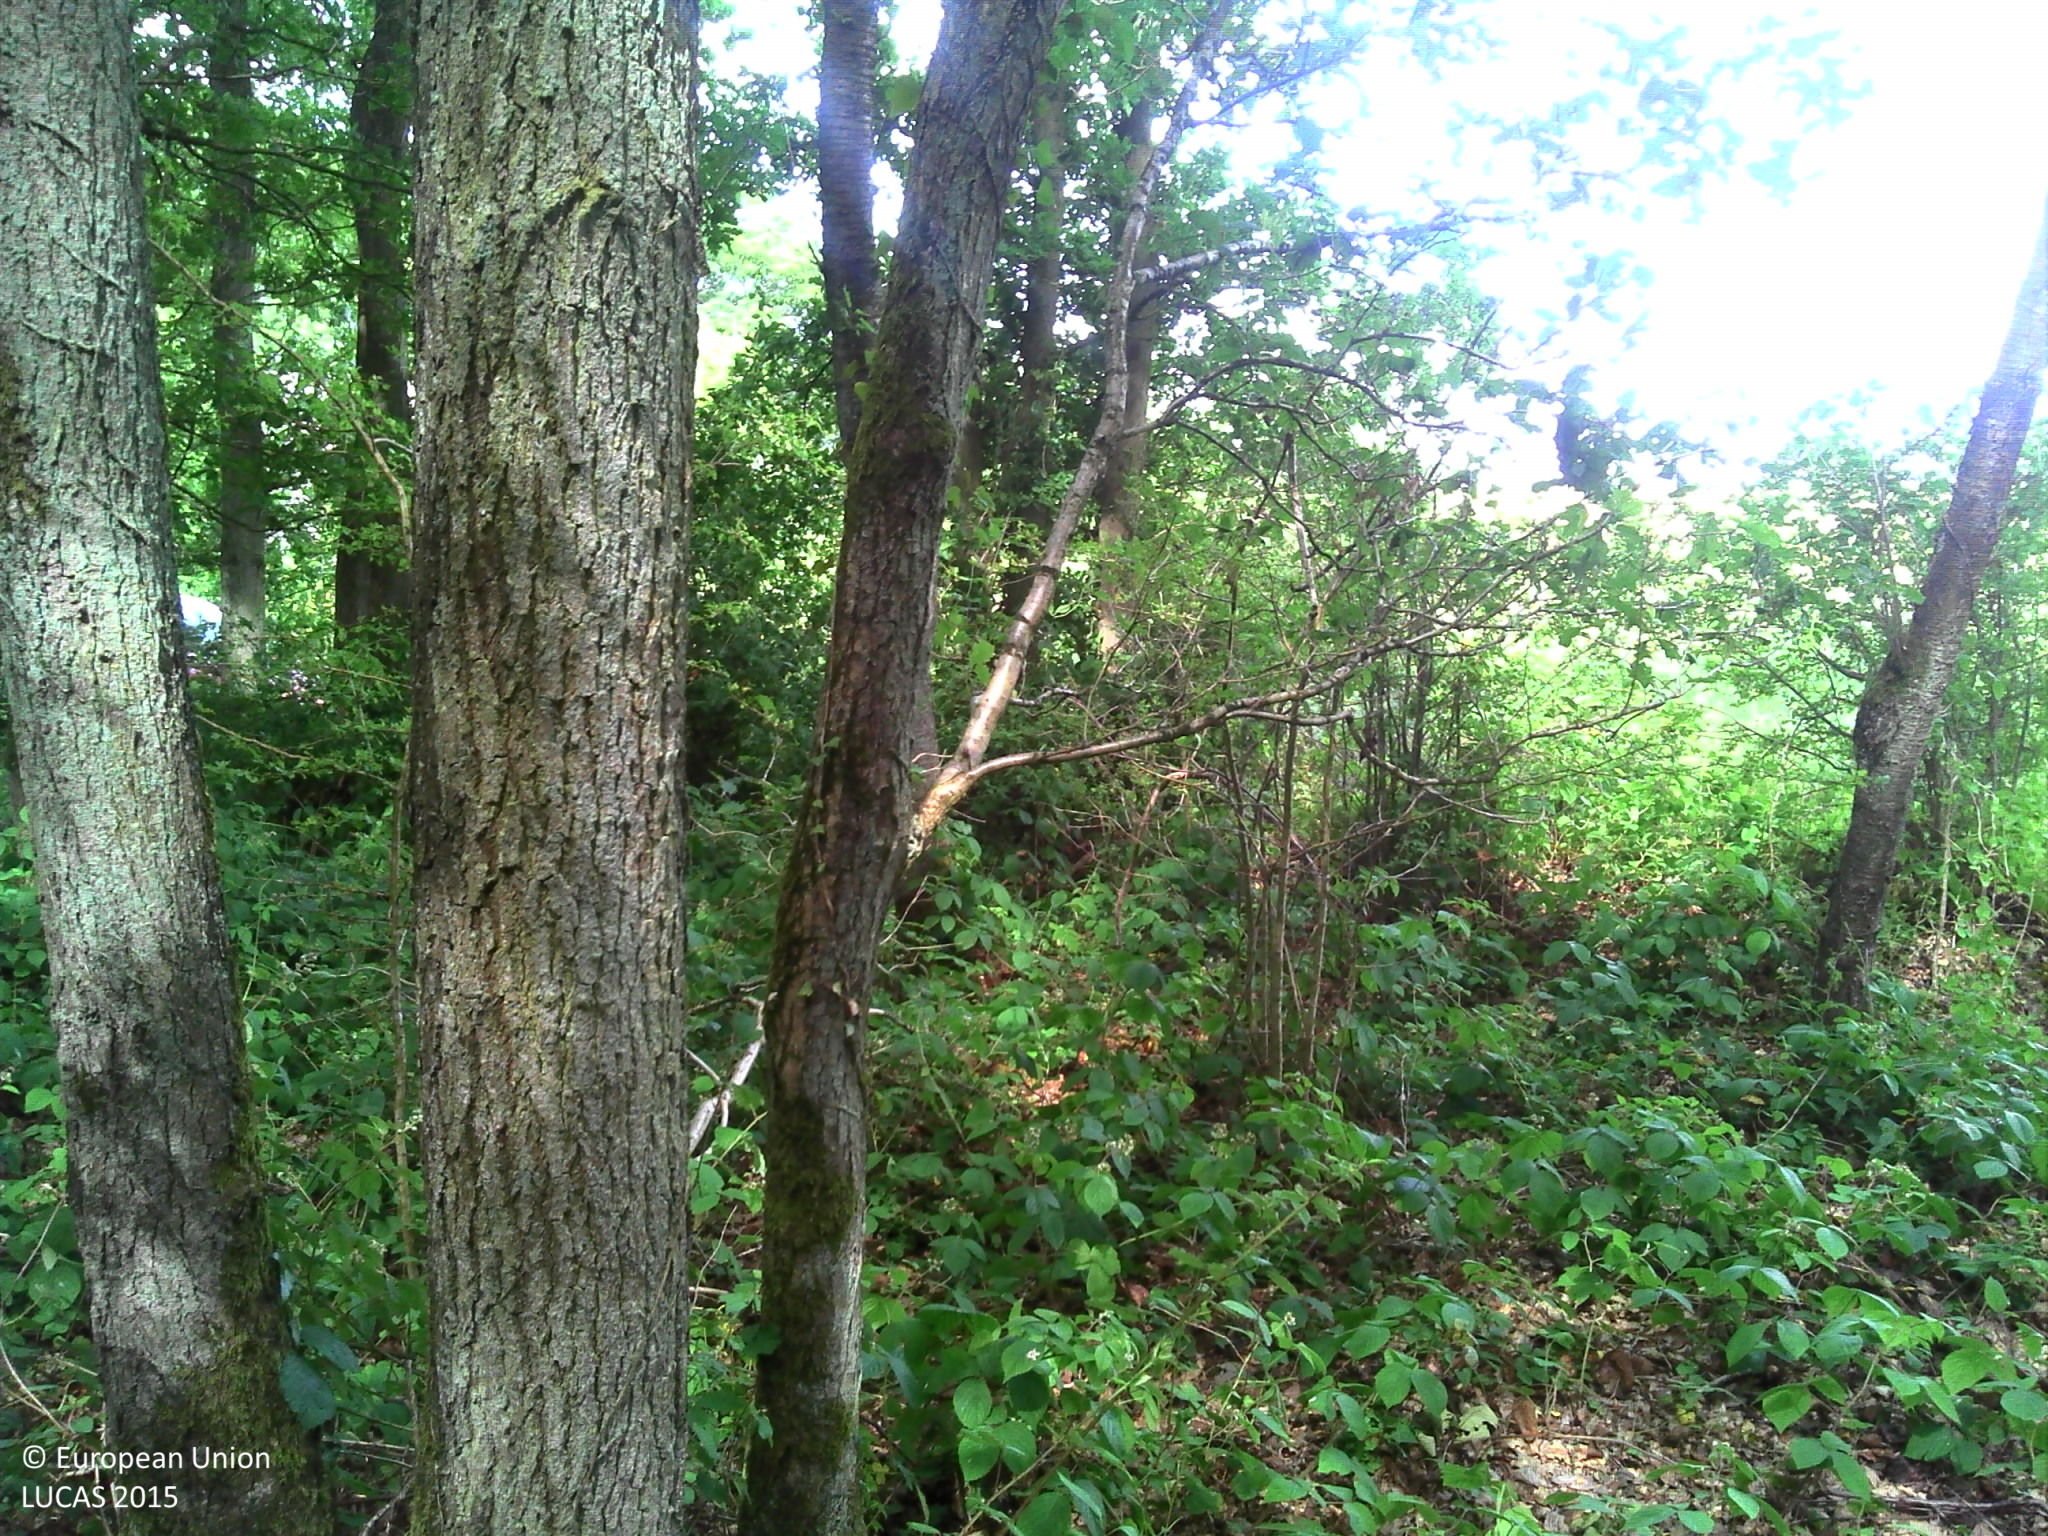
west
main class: Woodland
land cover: Broadleaved woodland
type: acidophilous oak and oak-birch forest
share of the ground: > 75 %
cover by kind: broadleaved forest trees 80 %, herbaceous plants 10 %, lichens and mosses 10 %
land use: Forestry
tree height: > 5 m
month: June
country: FR
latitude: 48.6105
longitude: 1.3967
